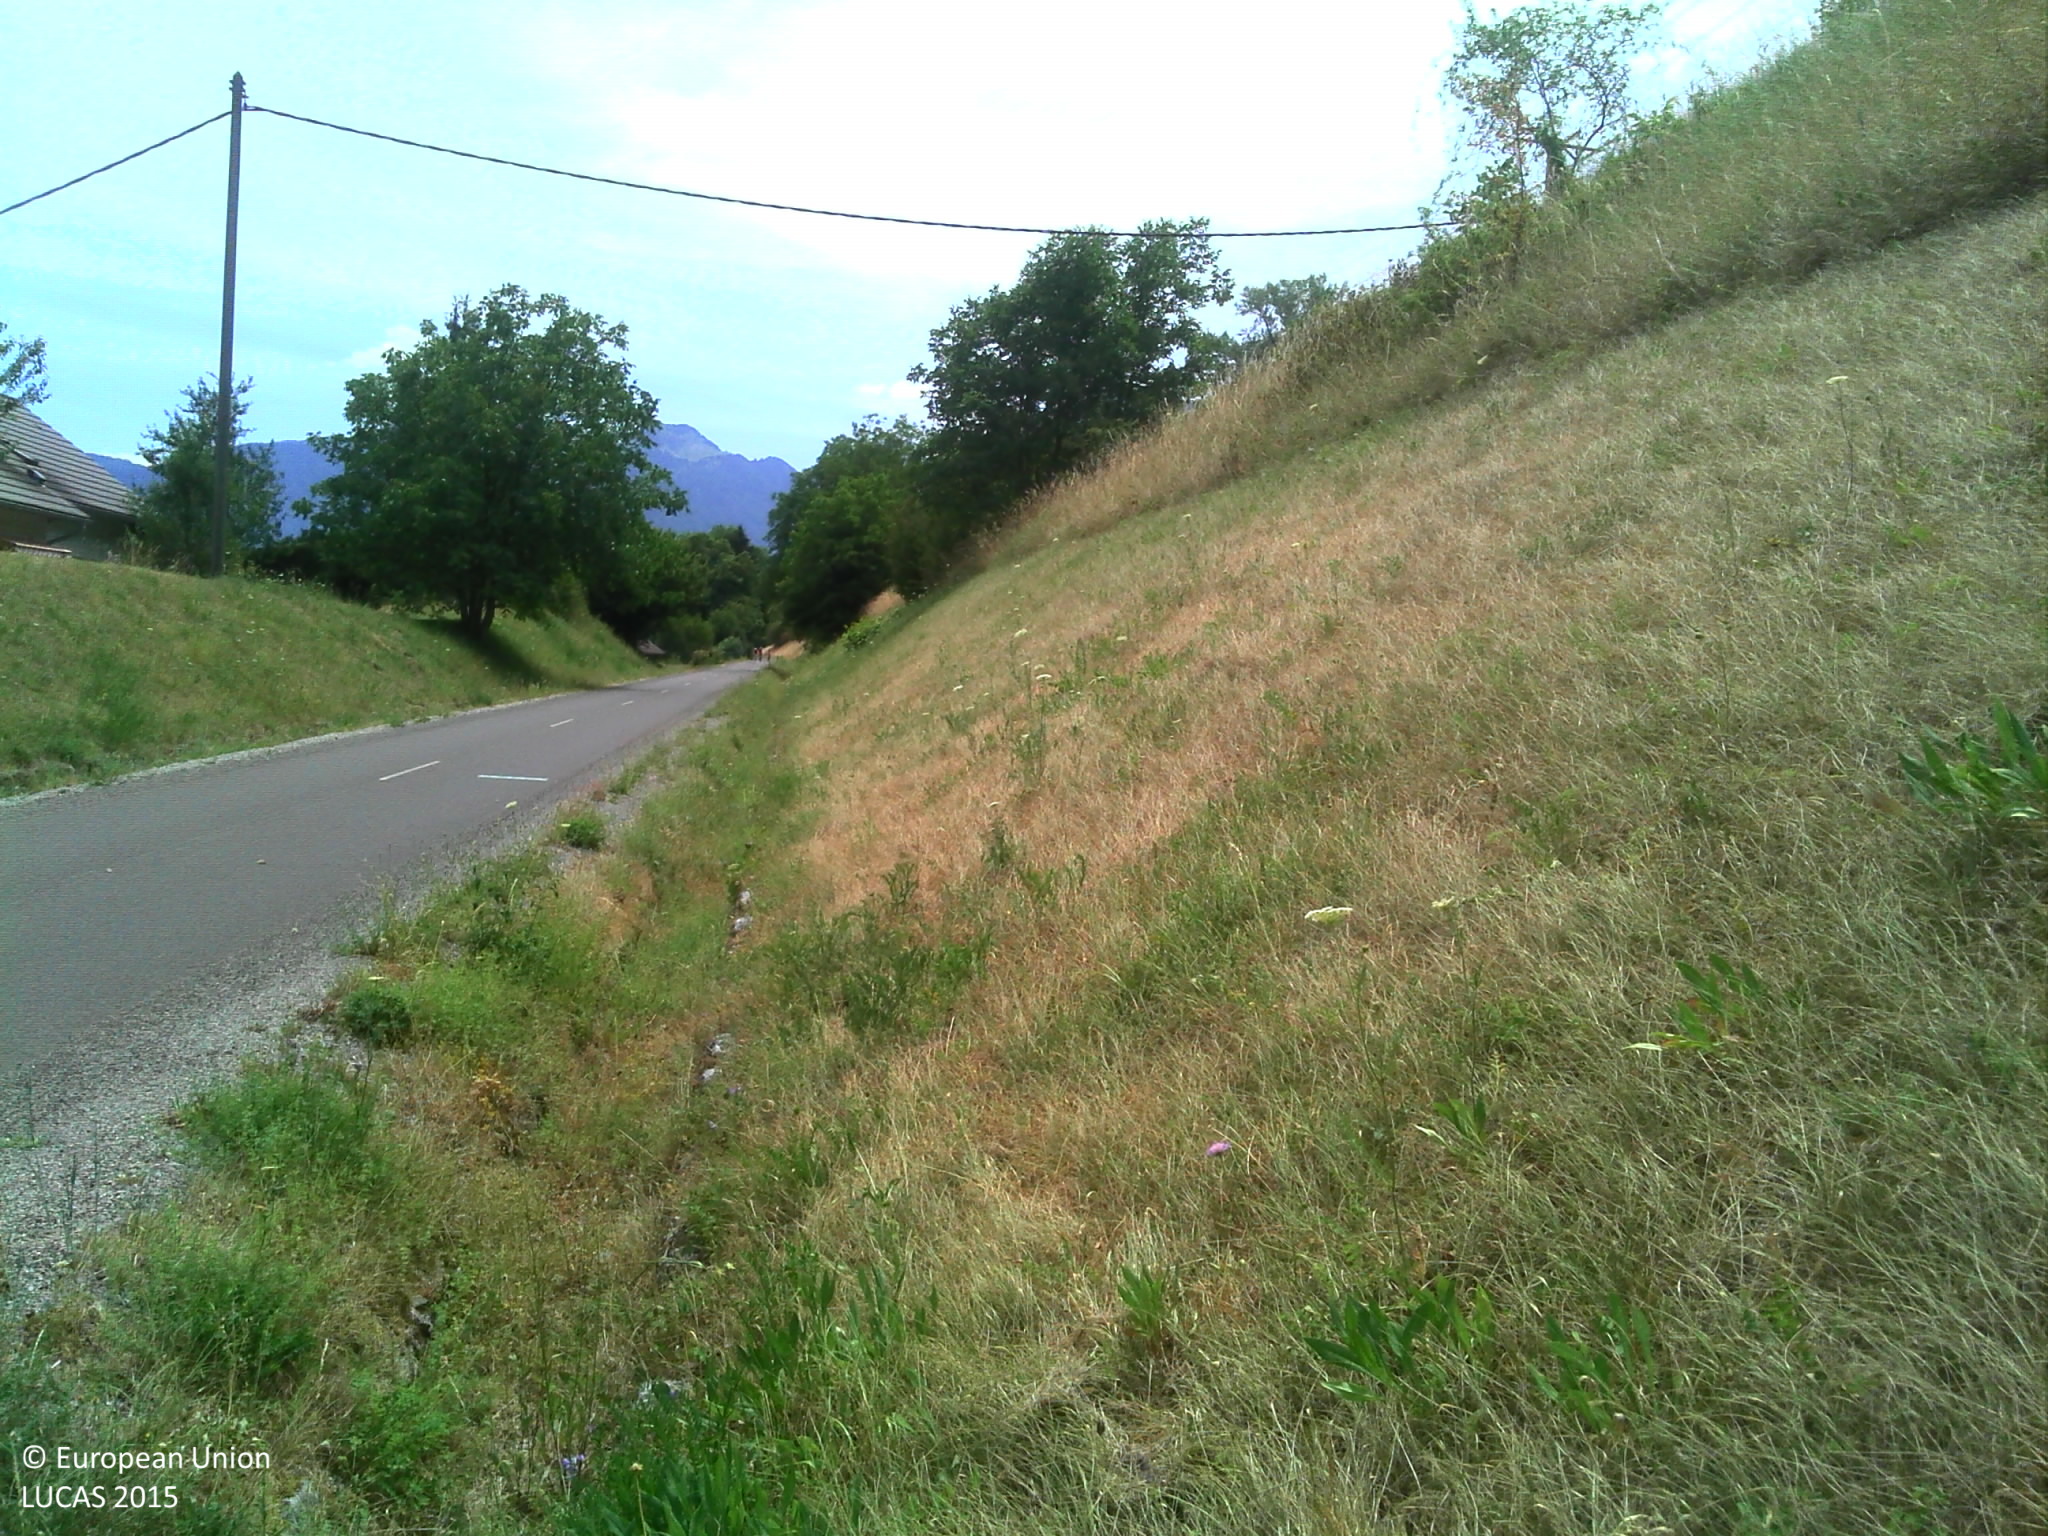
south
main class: Grassland
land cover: Grassland with sparse tree/shrub cover
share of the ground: > 75 %
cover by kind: herbaceous plants 90 %, broadleaved forest trees 5 %, shrubs 5 %
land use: Semi-natural and natural areas not in use
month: July
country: FR
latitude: 45.8151
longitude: 6.2076
